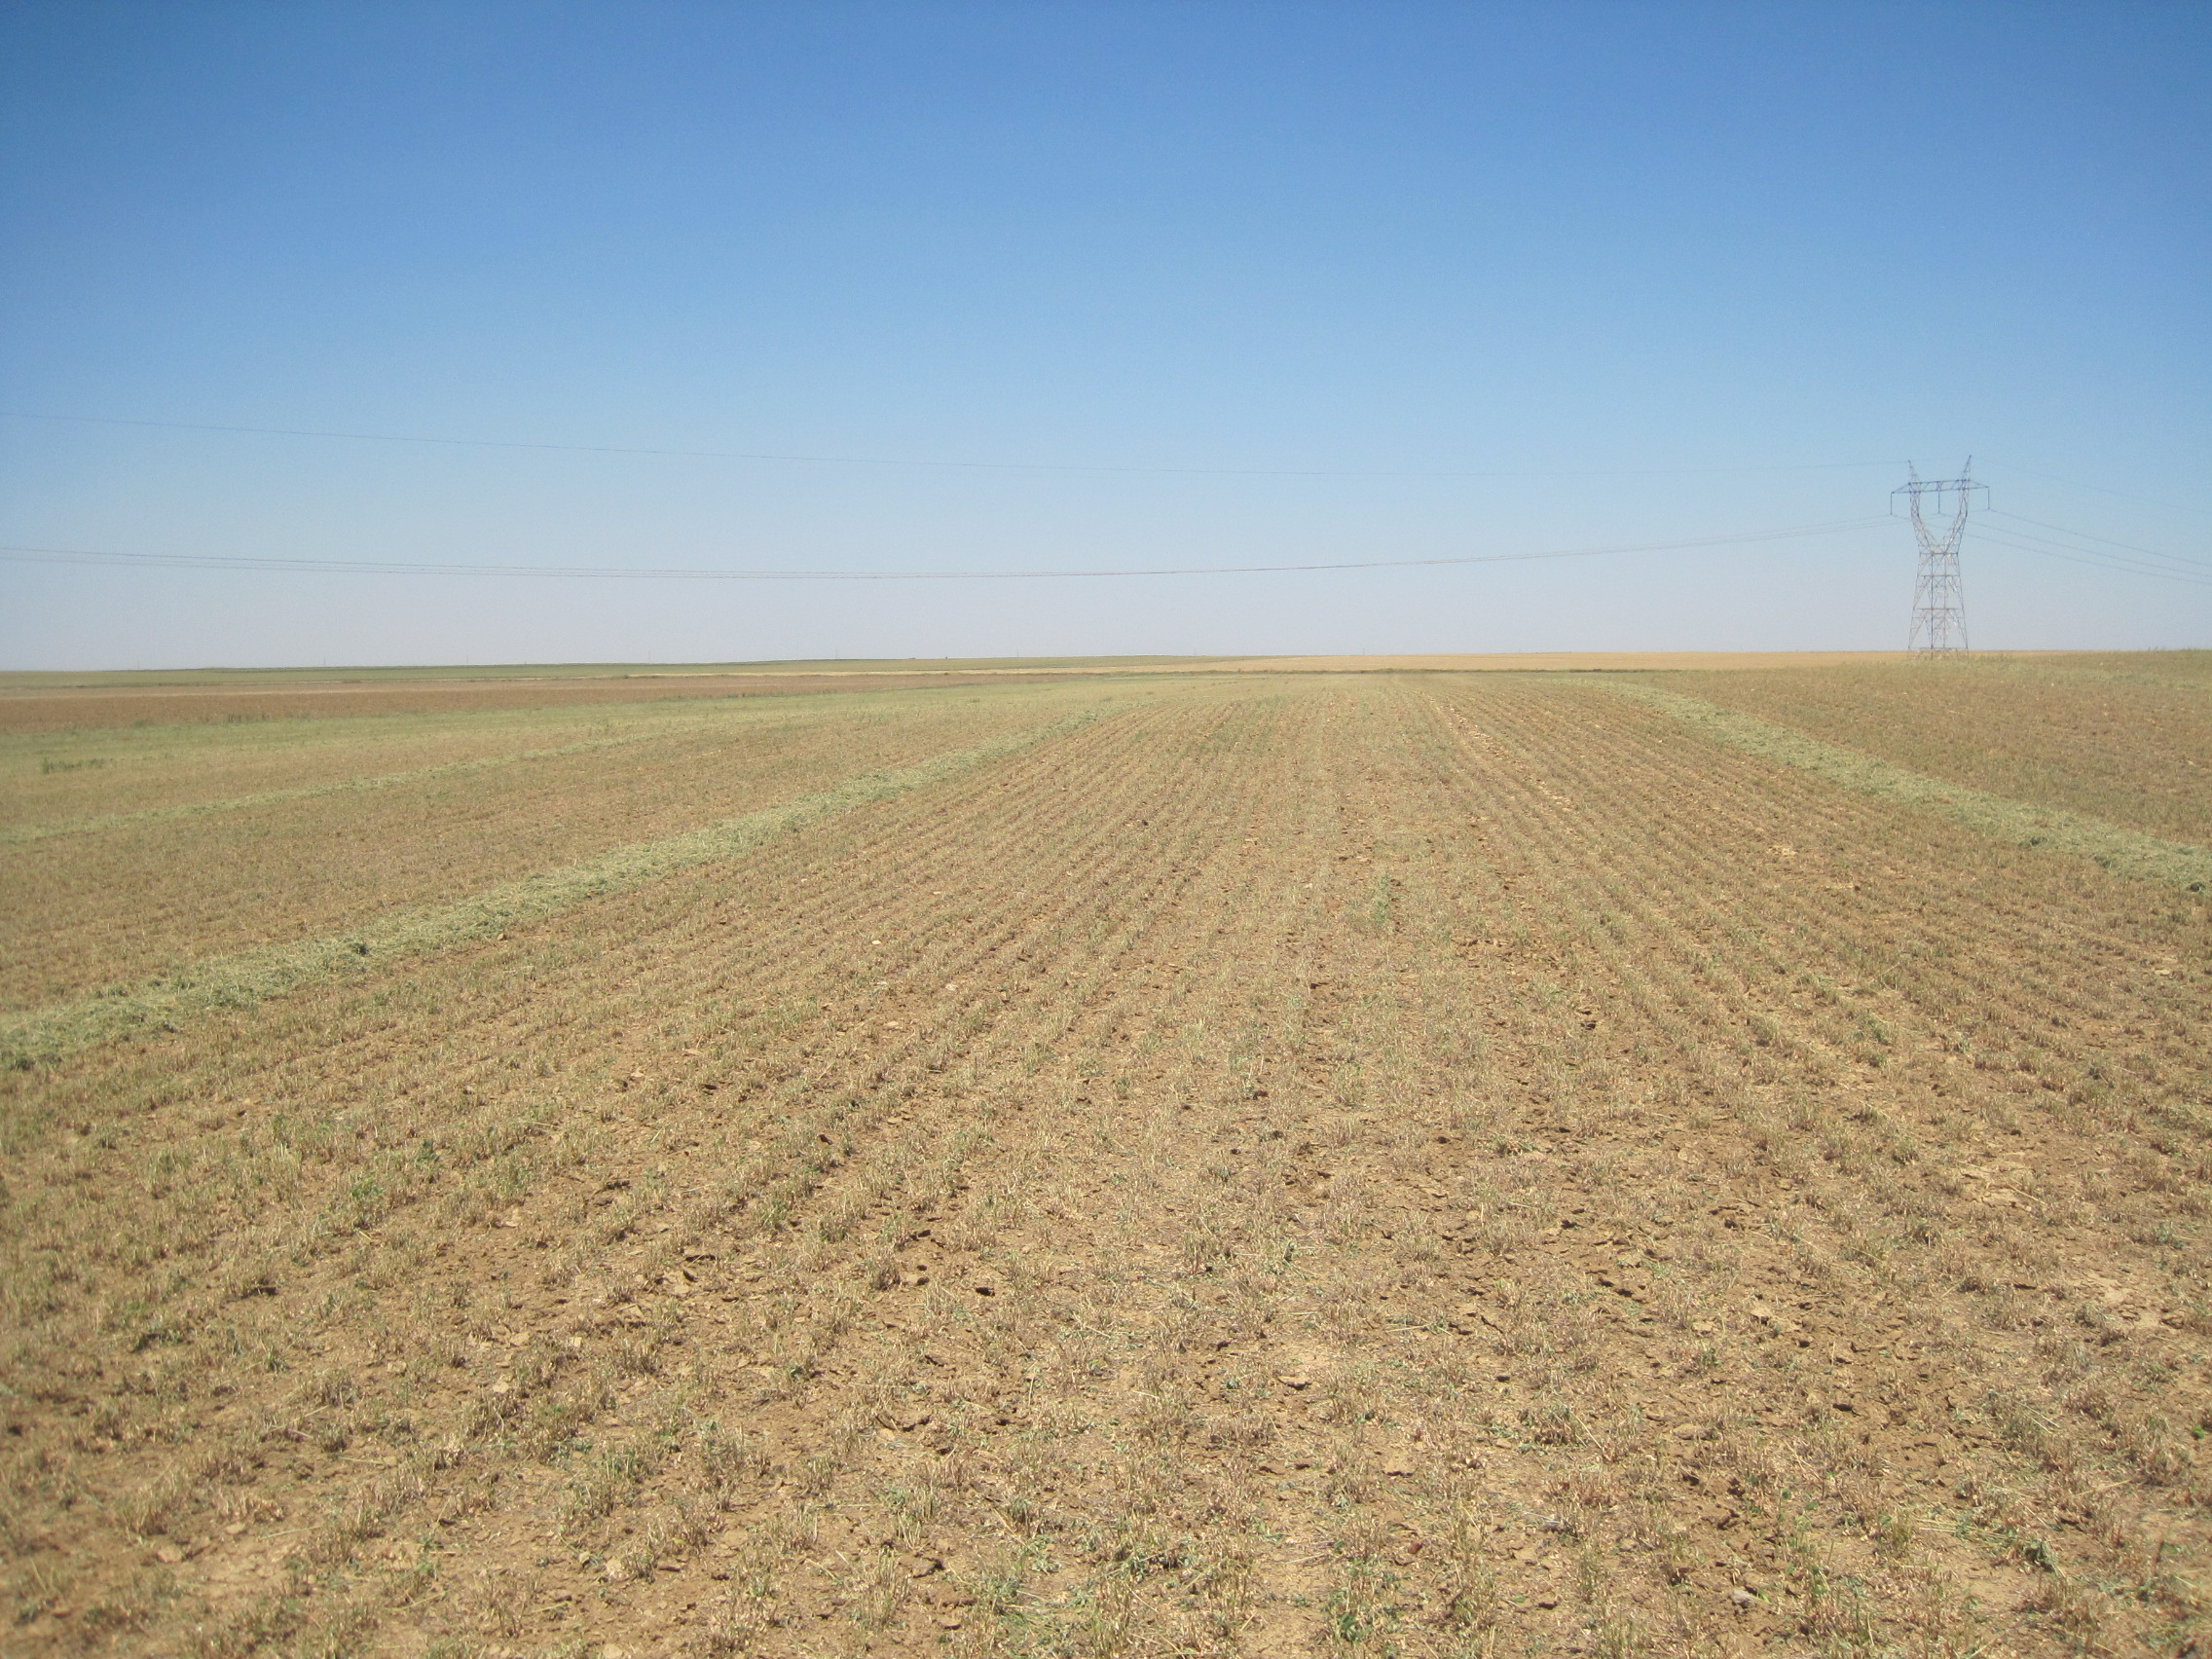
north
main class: Cropland
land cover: Lucerne
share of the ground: < 10 %
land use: Agriculture (excluding fallow land and kitchen gardens)
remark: Harvested field
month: July
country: ES
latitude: 41.9904
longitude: -4.7398
